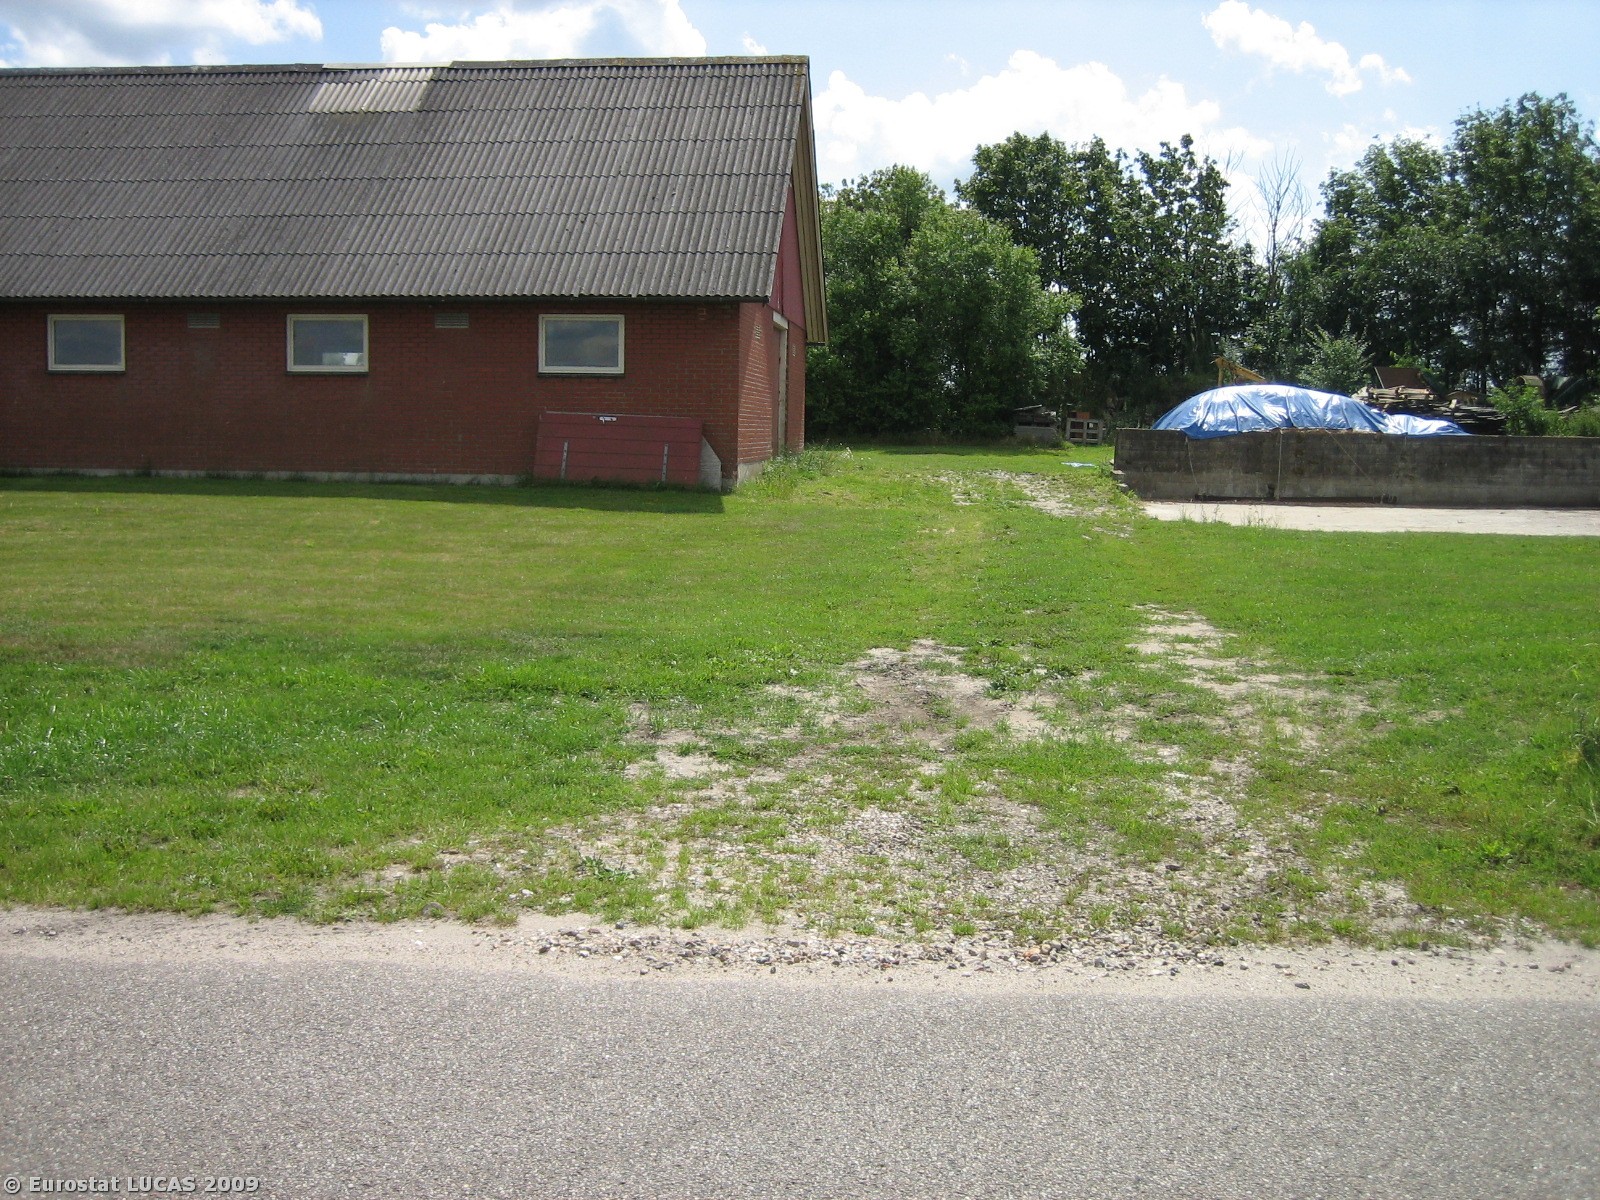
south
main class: Cropland
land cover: Barley
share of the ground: > 75 %
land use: Agriculture (excluding fallow land and kitchen gardens)
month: July
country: DK
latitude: 55.7164
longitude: 8.9982
